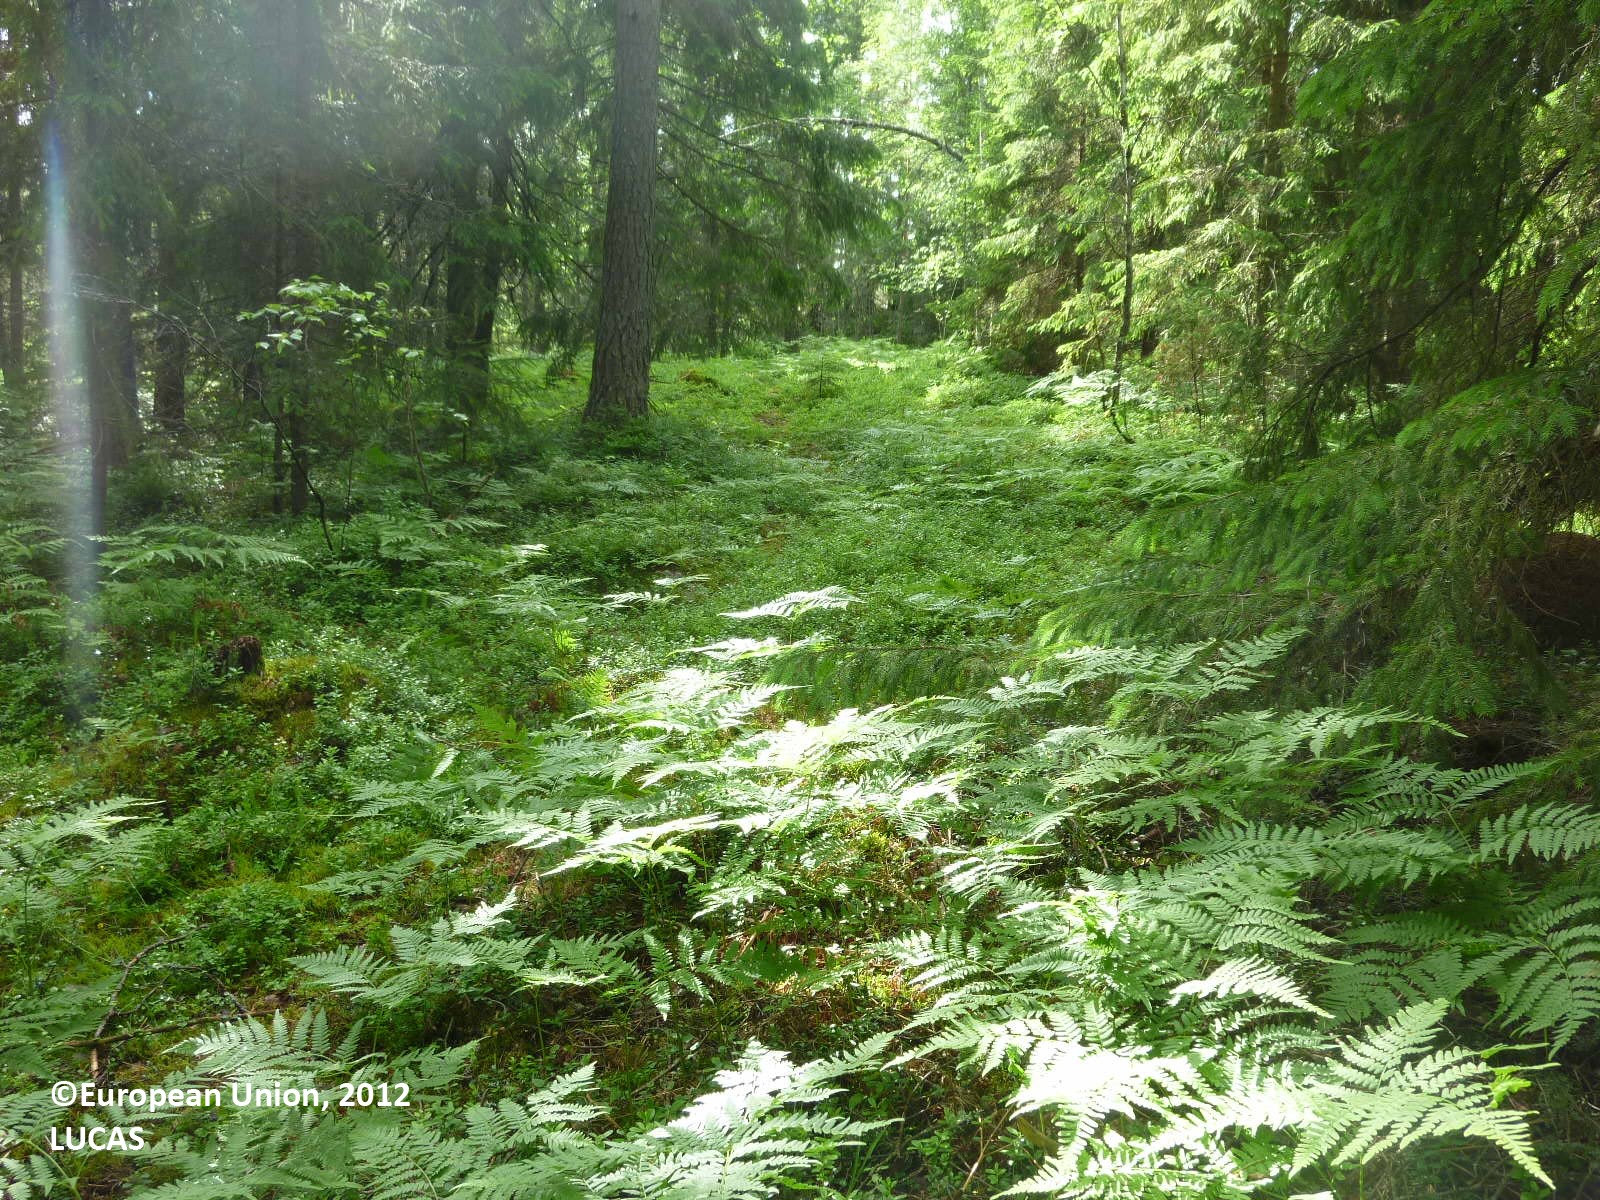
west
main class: Woodland
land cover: Spruce dominated coniferous woodland
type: boreal forest
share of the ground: 50 - 75 %
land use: Forestry
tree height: > 5 m
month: June
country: FI
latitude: 60.2671
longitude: 22.6366
